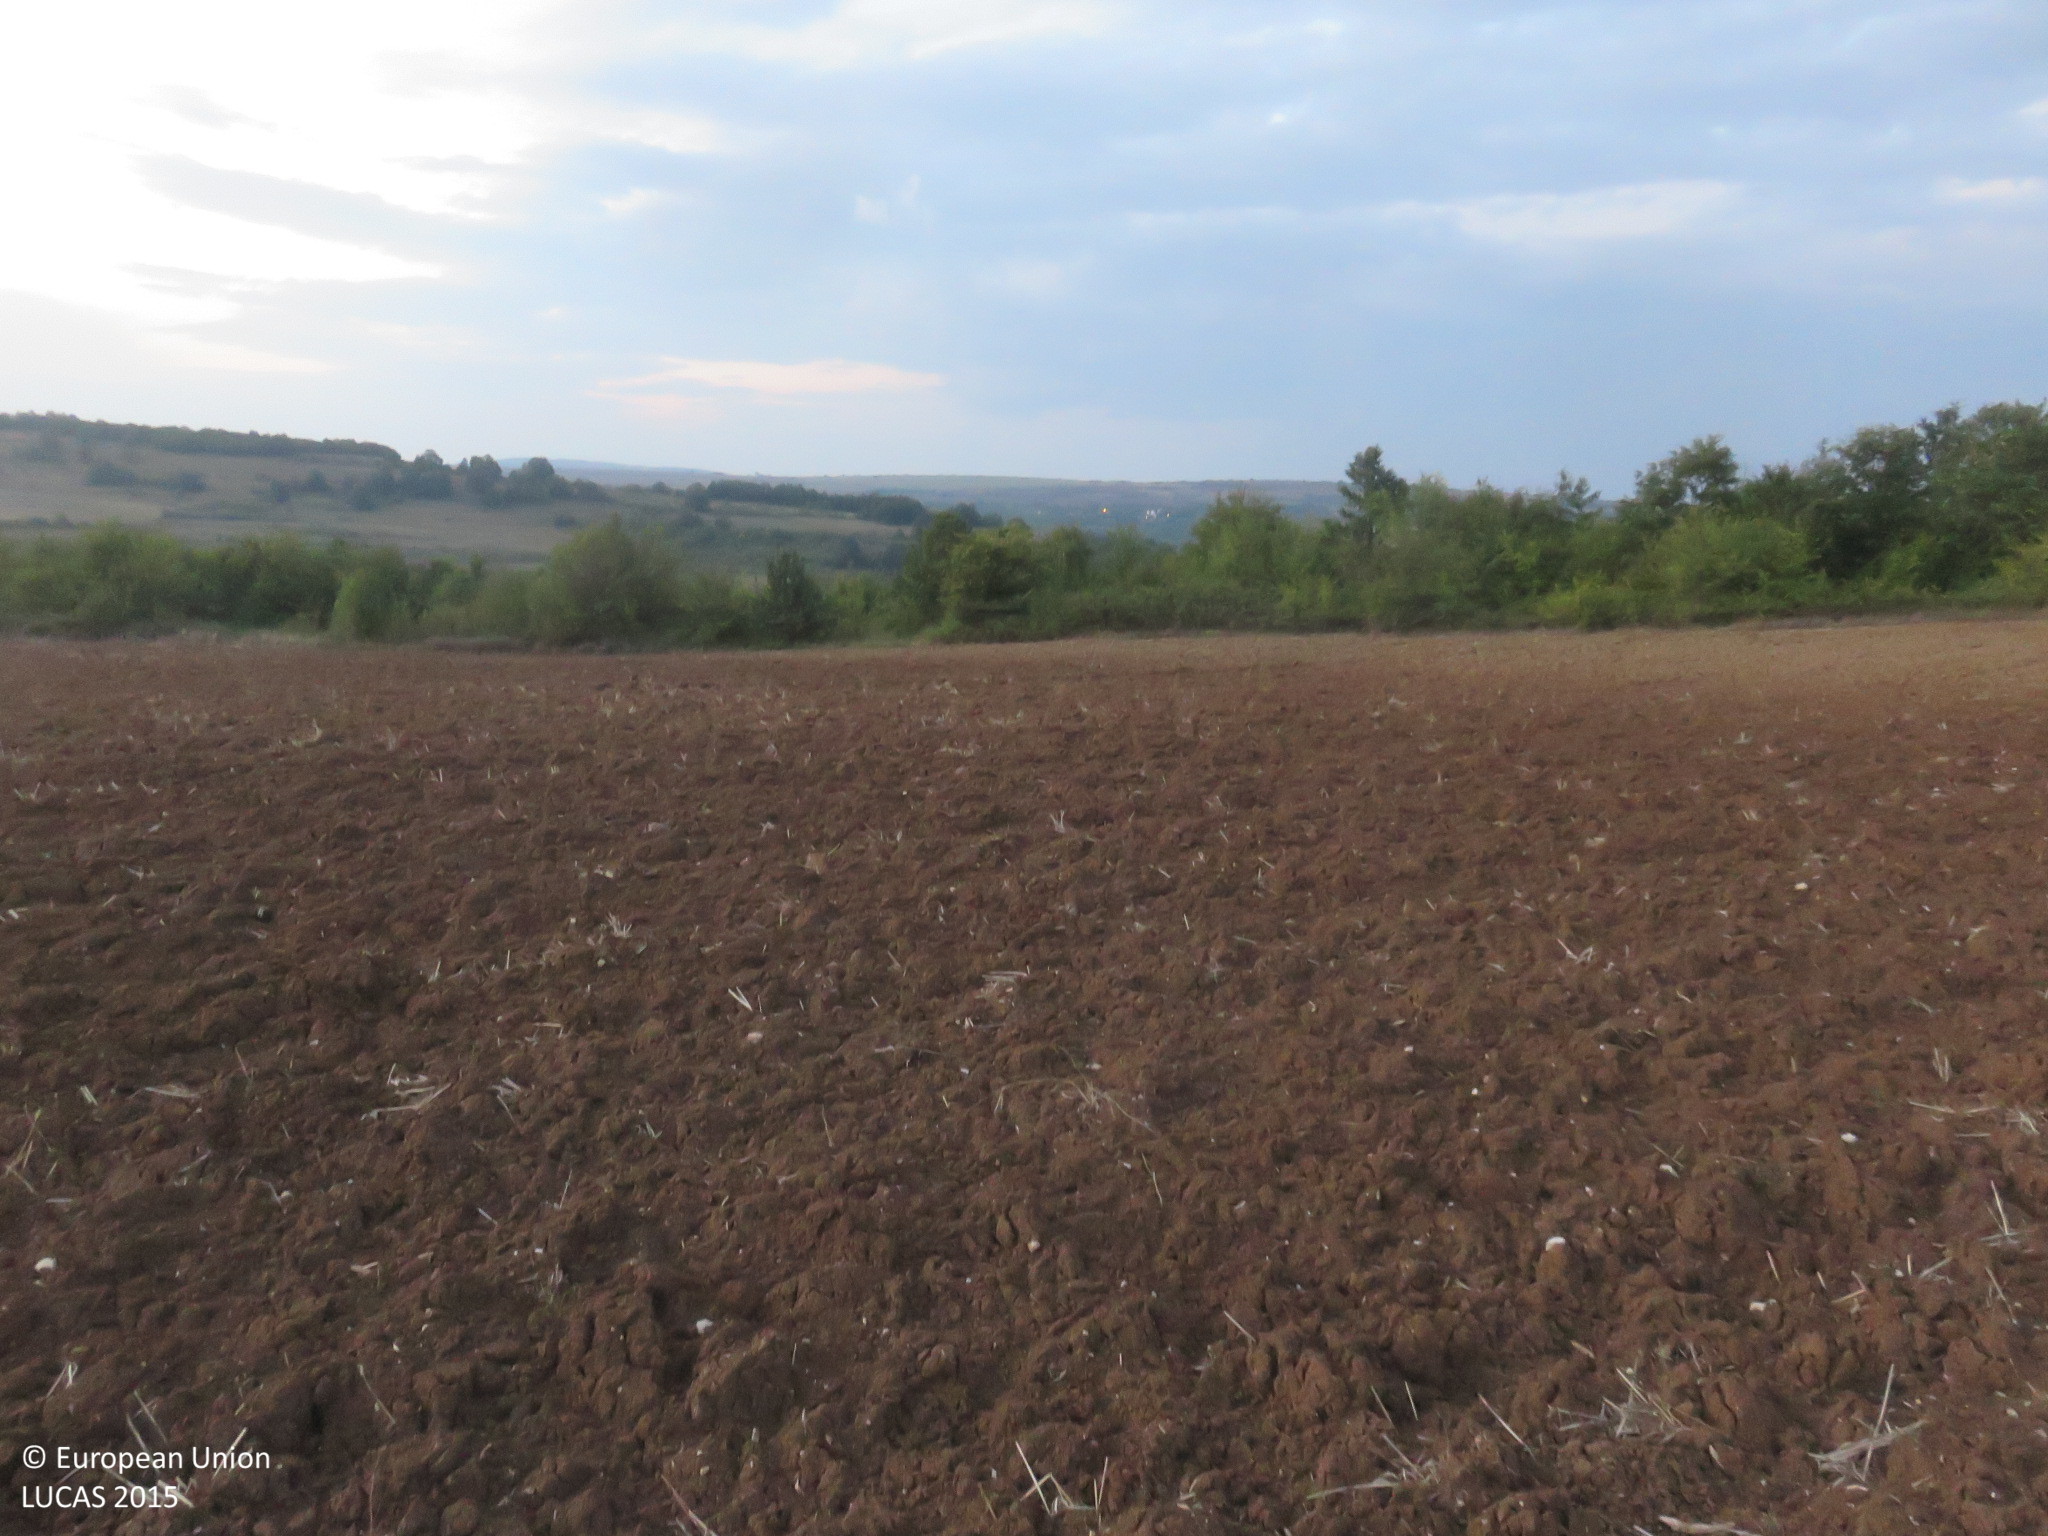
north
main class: Cropland
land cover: Common wheat
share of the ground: < 10 %
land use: Agriculture (excluding fallow land and kitchen gardens)
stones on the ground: < 10 %
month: September
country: BG
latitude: 43.0679
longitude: 25.0119
